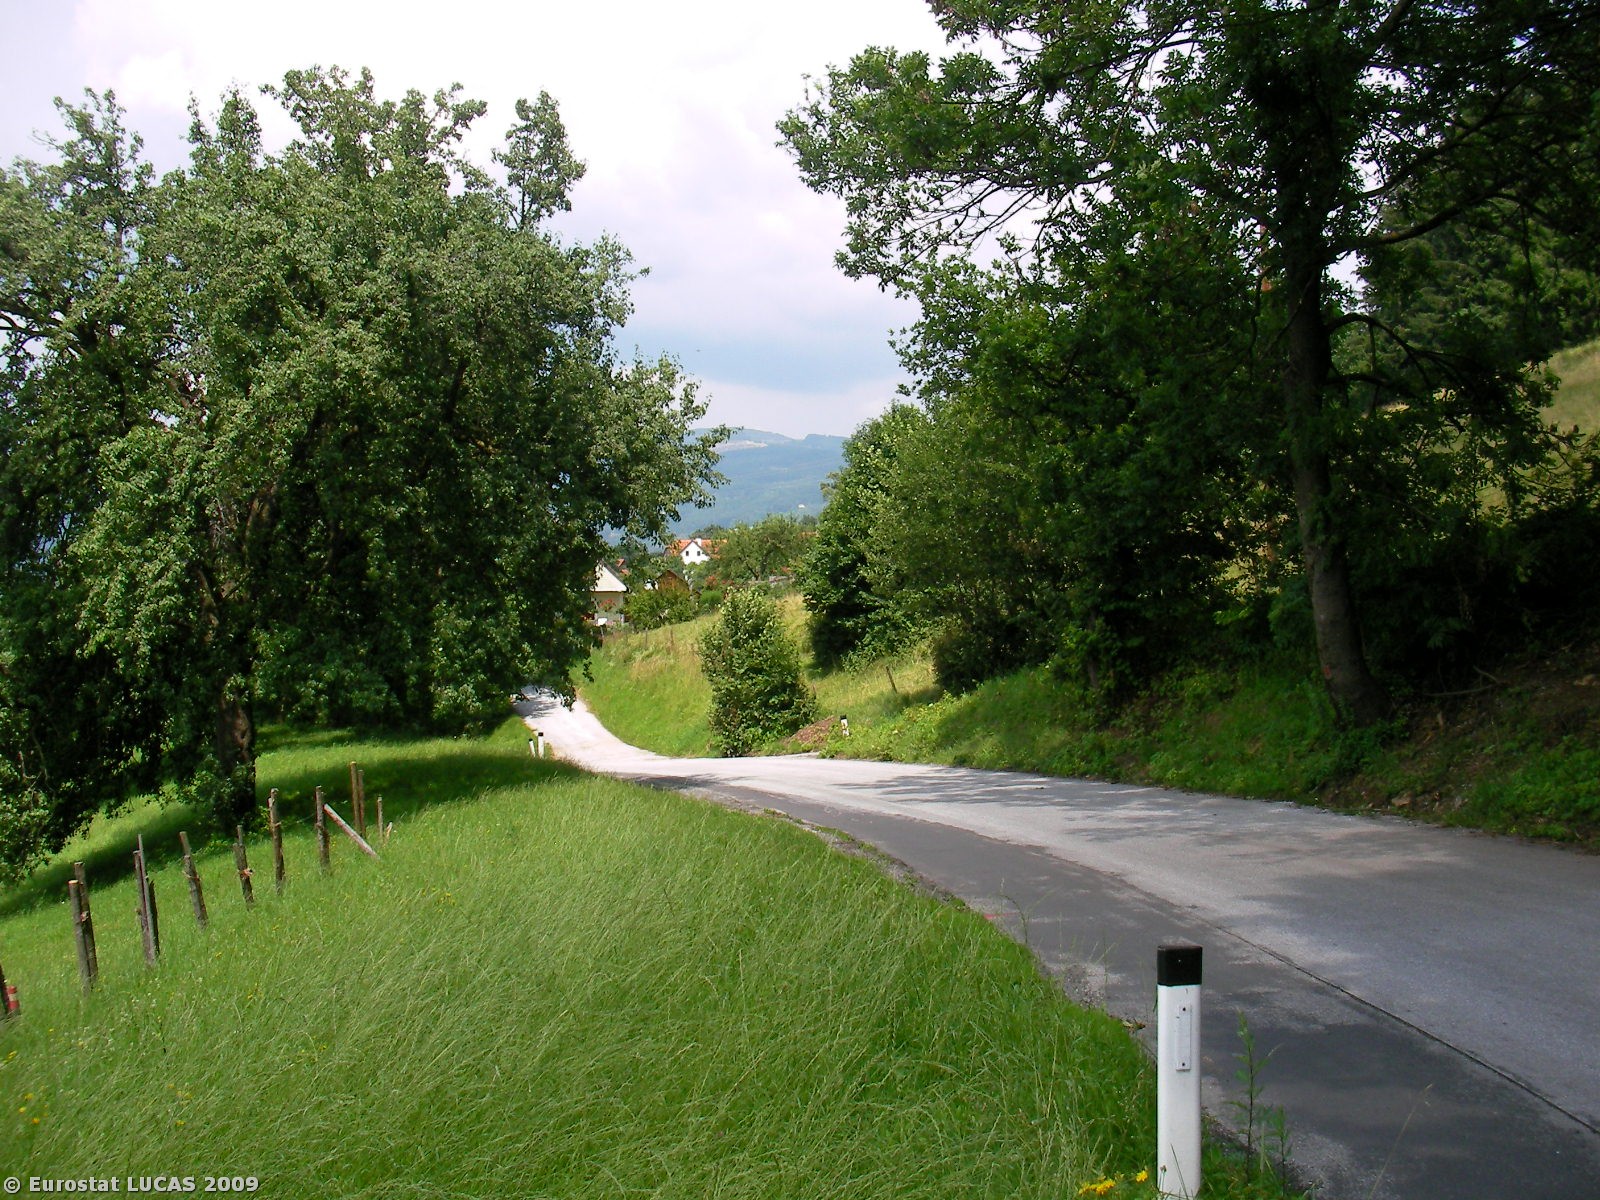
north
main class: Grassland
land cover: Grassland without tree/shrub cover
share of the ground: > 75 %
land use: Agriculture (excluding fallow land and kitchen gardens)
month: July
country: AT
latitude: 47.2257
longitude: 15.7458
